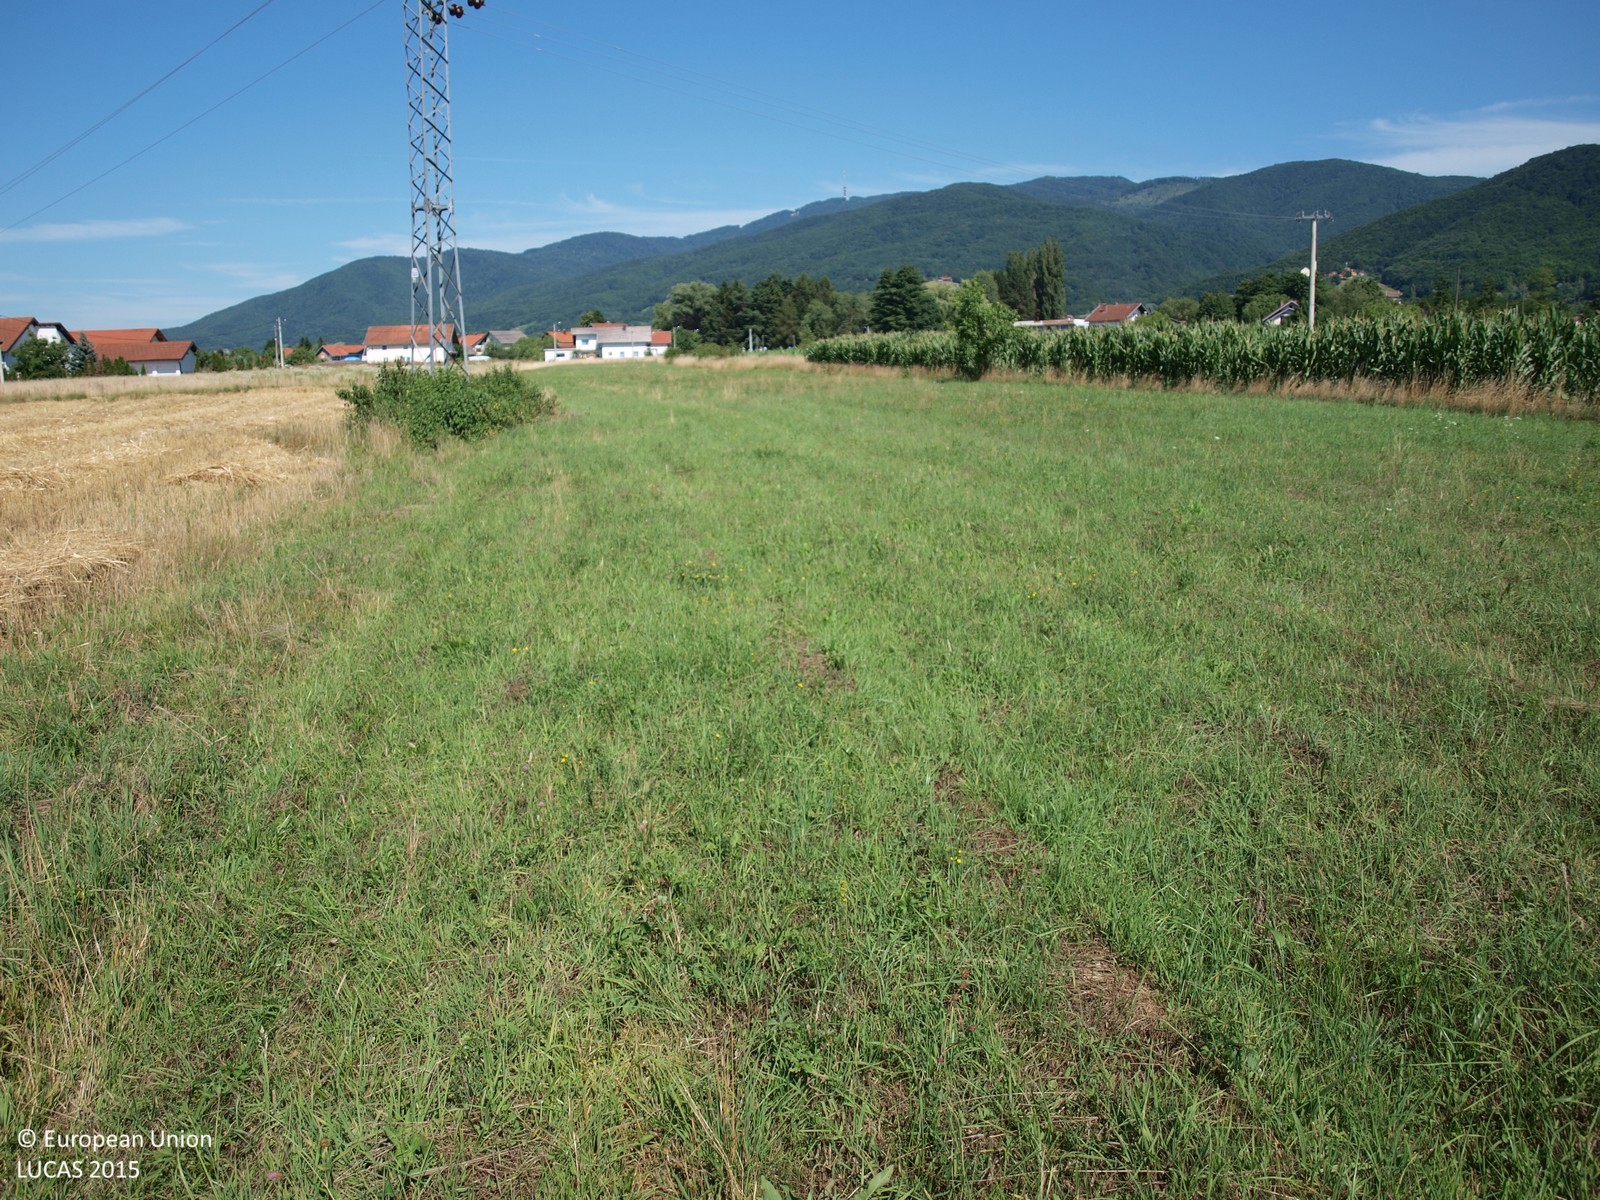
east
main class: Grassland
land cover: Grassland without tree/shrub cover
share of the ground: > 75 %
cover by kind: herbaceous plants 100 %
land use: Agriculture (excluding fallow land and kitchen gardens)
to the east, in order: Grassland without tree/shrub cover; Electric lines; Grassland without tree/shrub cover; Electric lines; Grassland without tree/shrub cover; Tracks; Grassland with sparse tree/shrub cover; Maize; Nurseries; Shrubland with sparse tree cover; Other bare soil
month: July
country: HR
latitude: 45.9015
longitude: 15.8626
